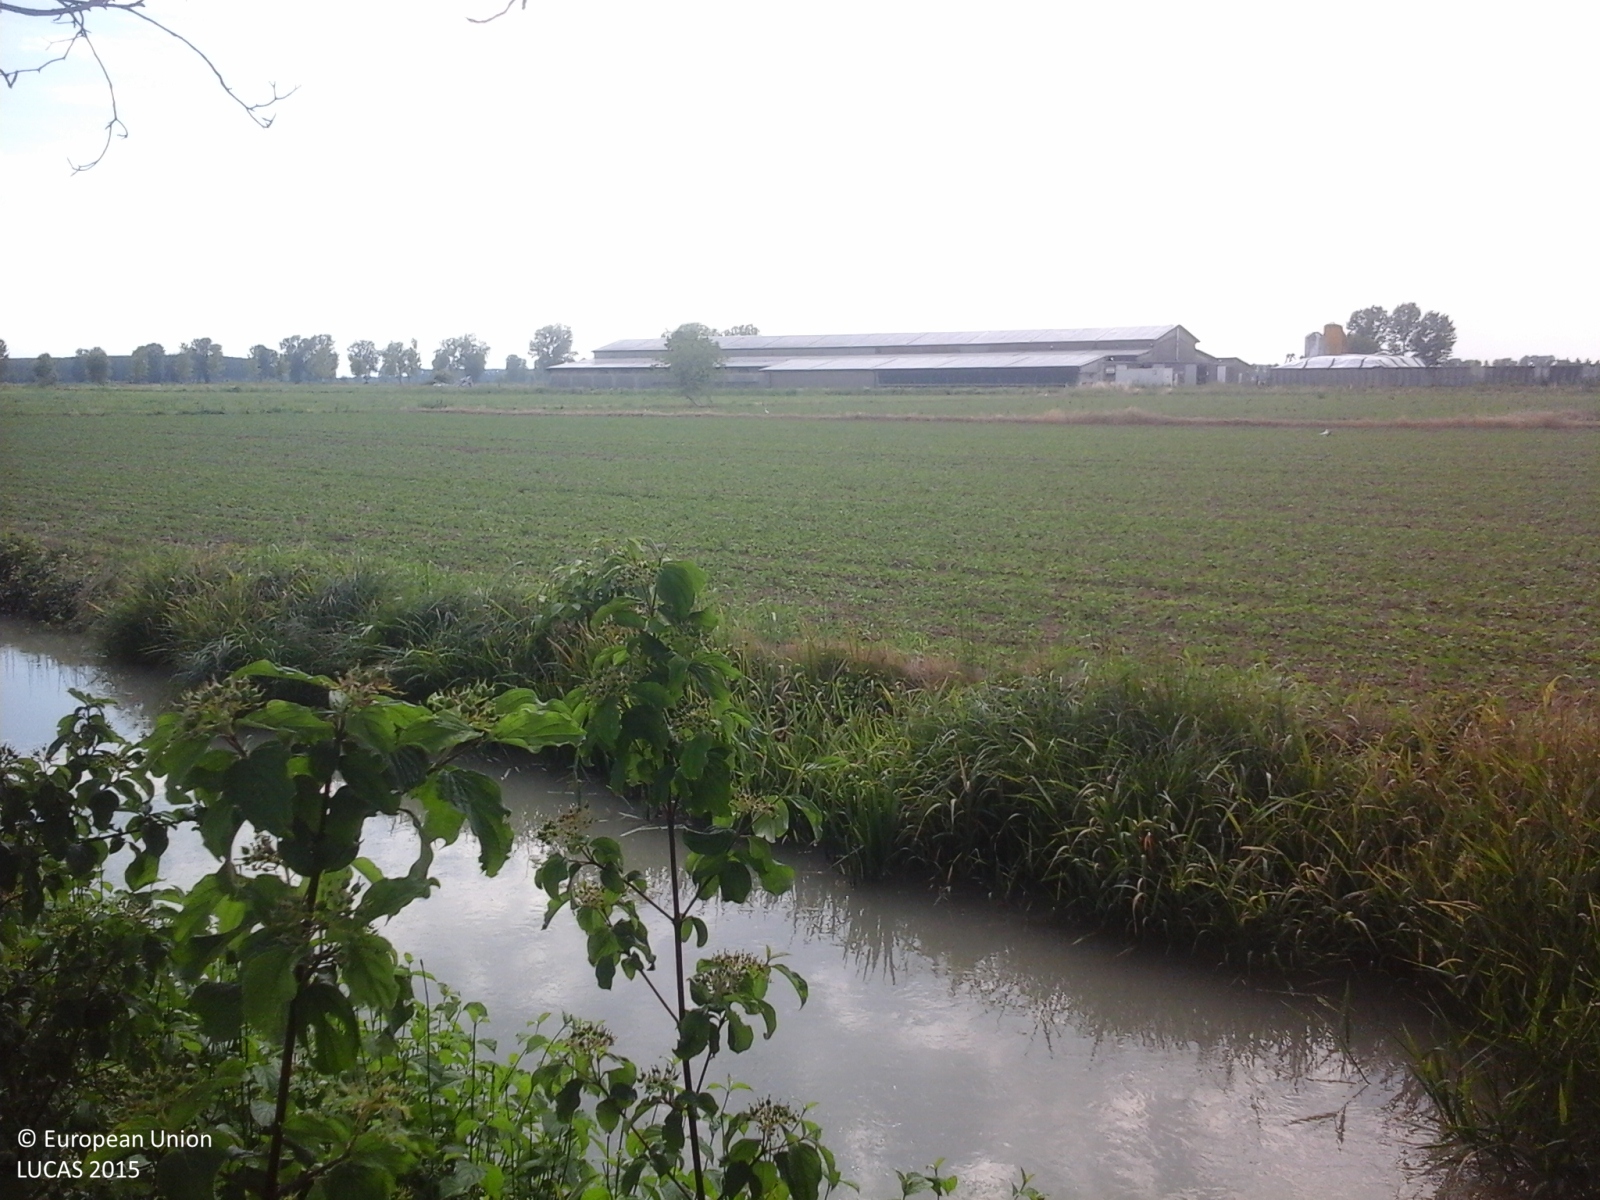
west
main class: Cropland
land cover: Soya
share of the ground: < 10 %
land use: Agriculture (excluding fallow land and kitchen gardens)
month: May
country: IT
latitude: 45.1213
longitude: 10.9770
